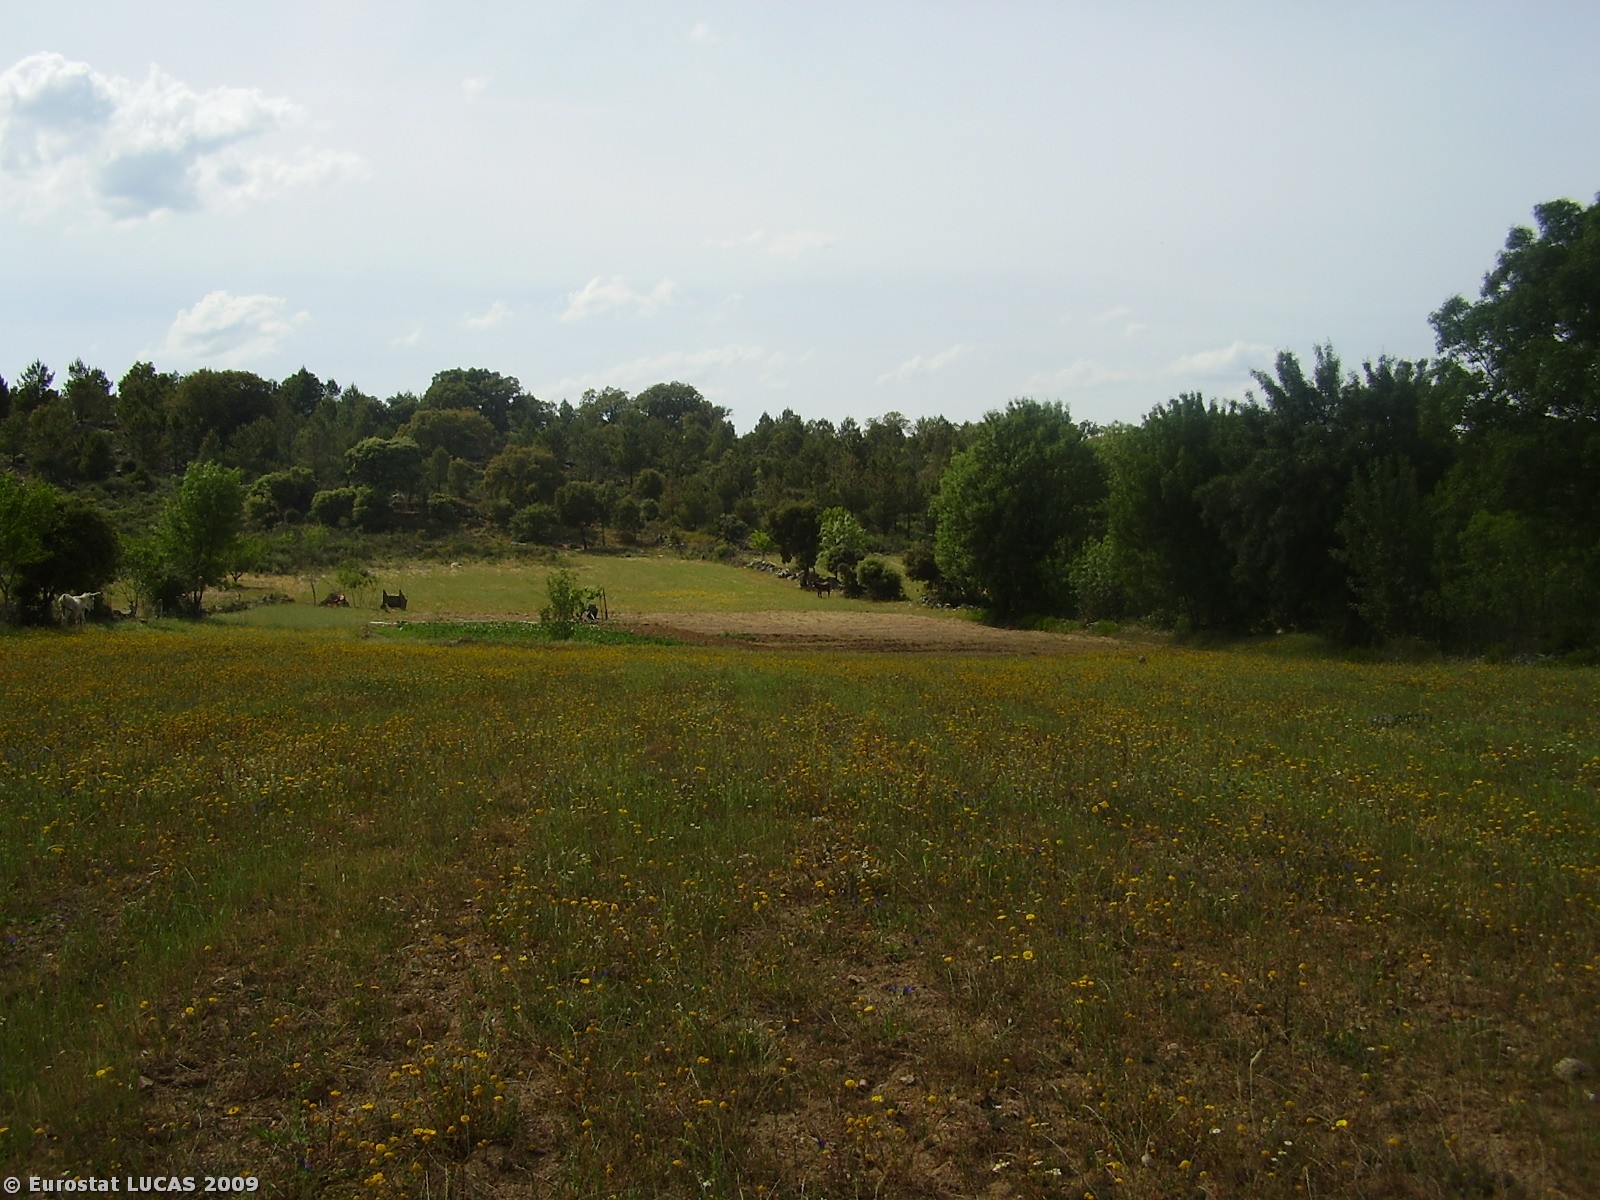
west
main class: Cropland
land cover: Mixed cereals for fodder
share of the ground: 50 - 75 %
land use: Agriculture (excluding fallow land and kitchen gardens)
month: May
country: PT
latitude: 41.5097
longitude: -7.0453
